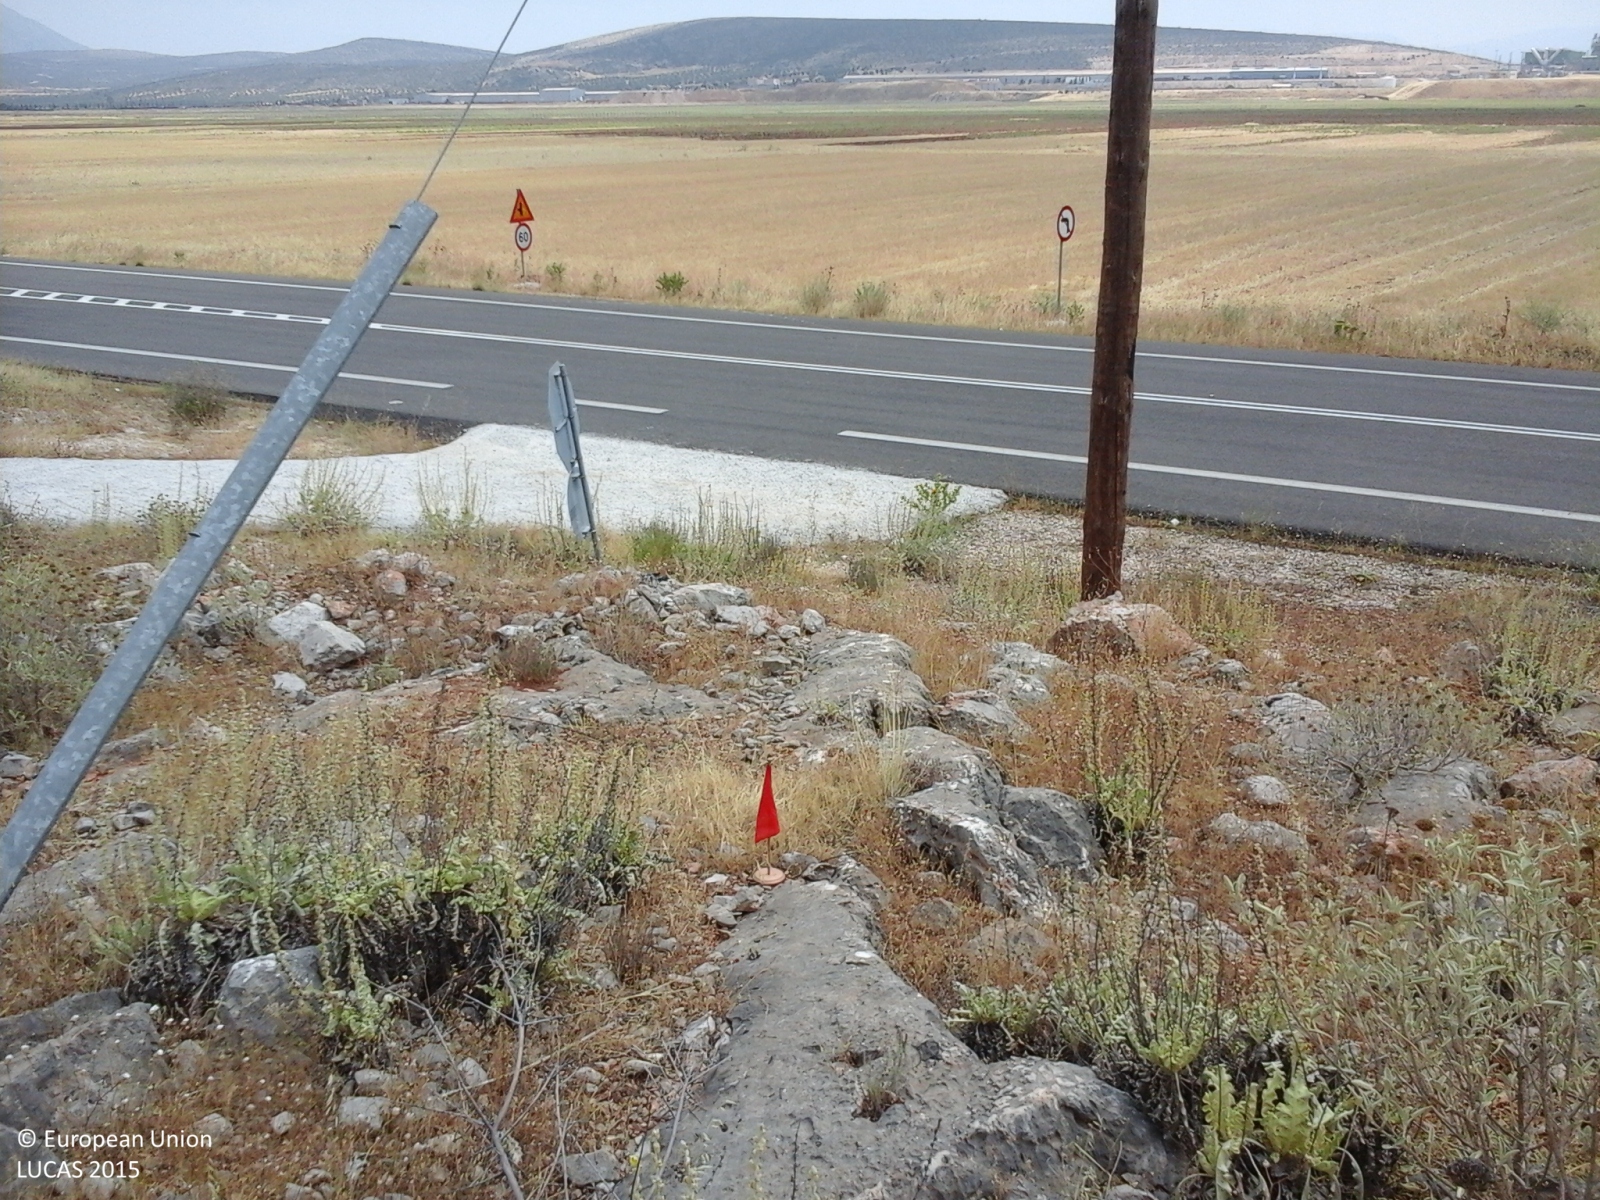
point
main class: Shrubland
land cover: Shrubland without tree cover
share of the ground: 50 - 75 %
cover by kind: shrubs 50 %, unconsolidated bare surface 30 %, herbaceous plants 10 %, consolidated bare surface 10 %
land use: Agriculture (excluding fallow land and kitchen gardens)
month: July
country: GR
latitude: 38.2519
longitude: 22.9465
